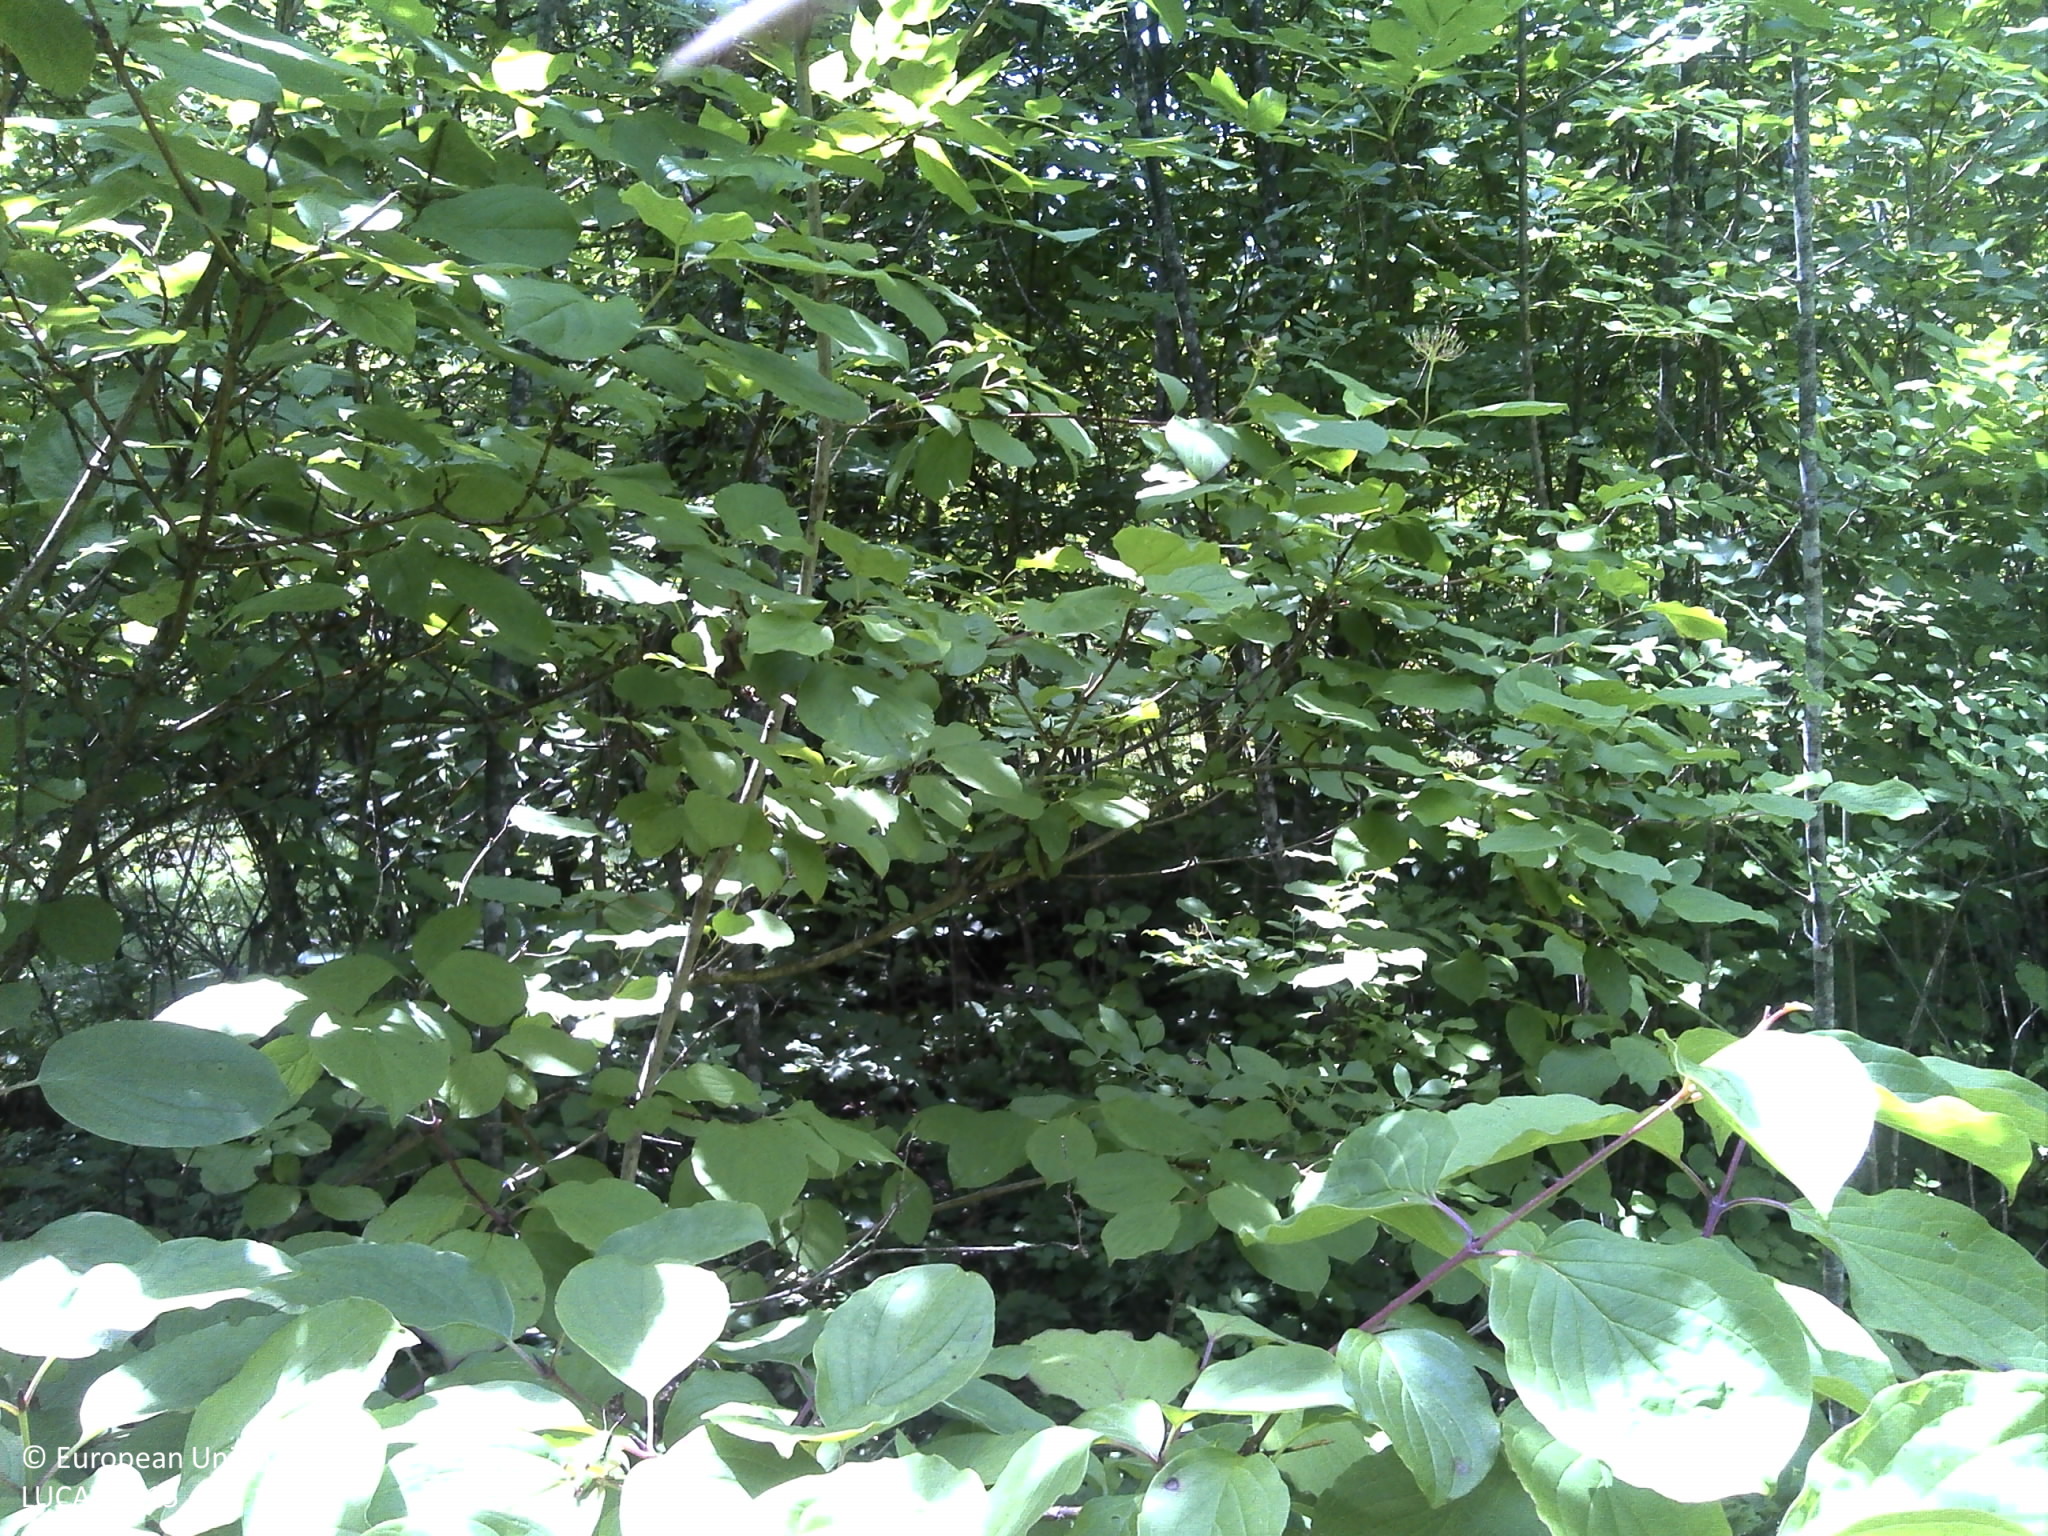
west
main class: Woodland
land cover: Broadleaved woodland
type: mountainous beech forest
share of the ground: > 75 %
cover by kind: broadleaved forest trees 90 %, herbaceous plants 10 %
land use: Forestry
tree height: > 5 m
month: June
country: HR
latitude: 44.5926
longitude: 16.0029
